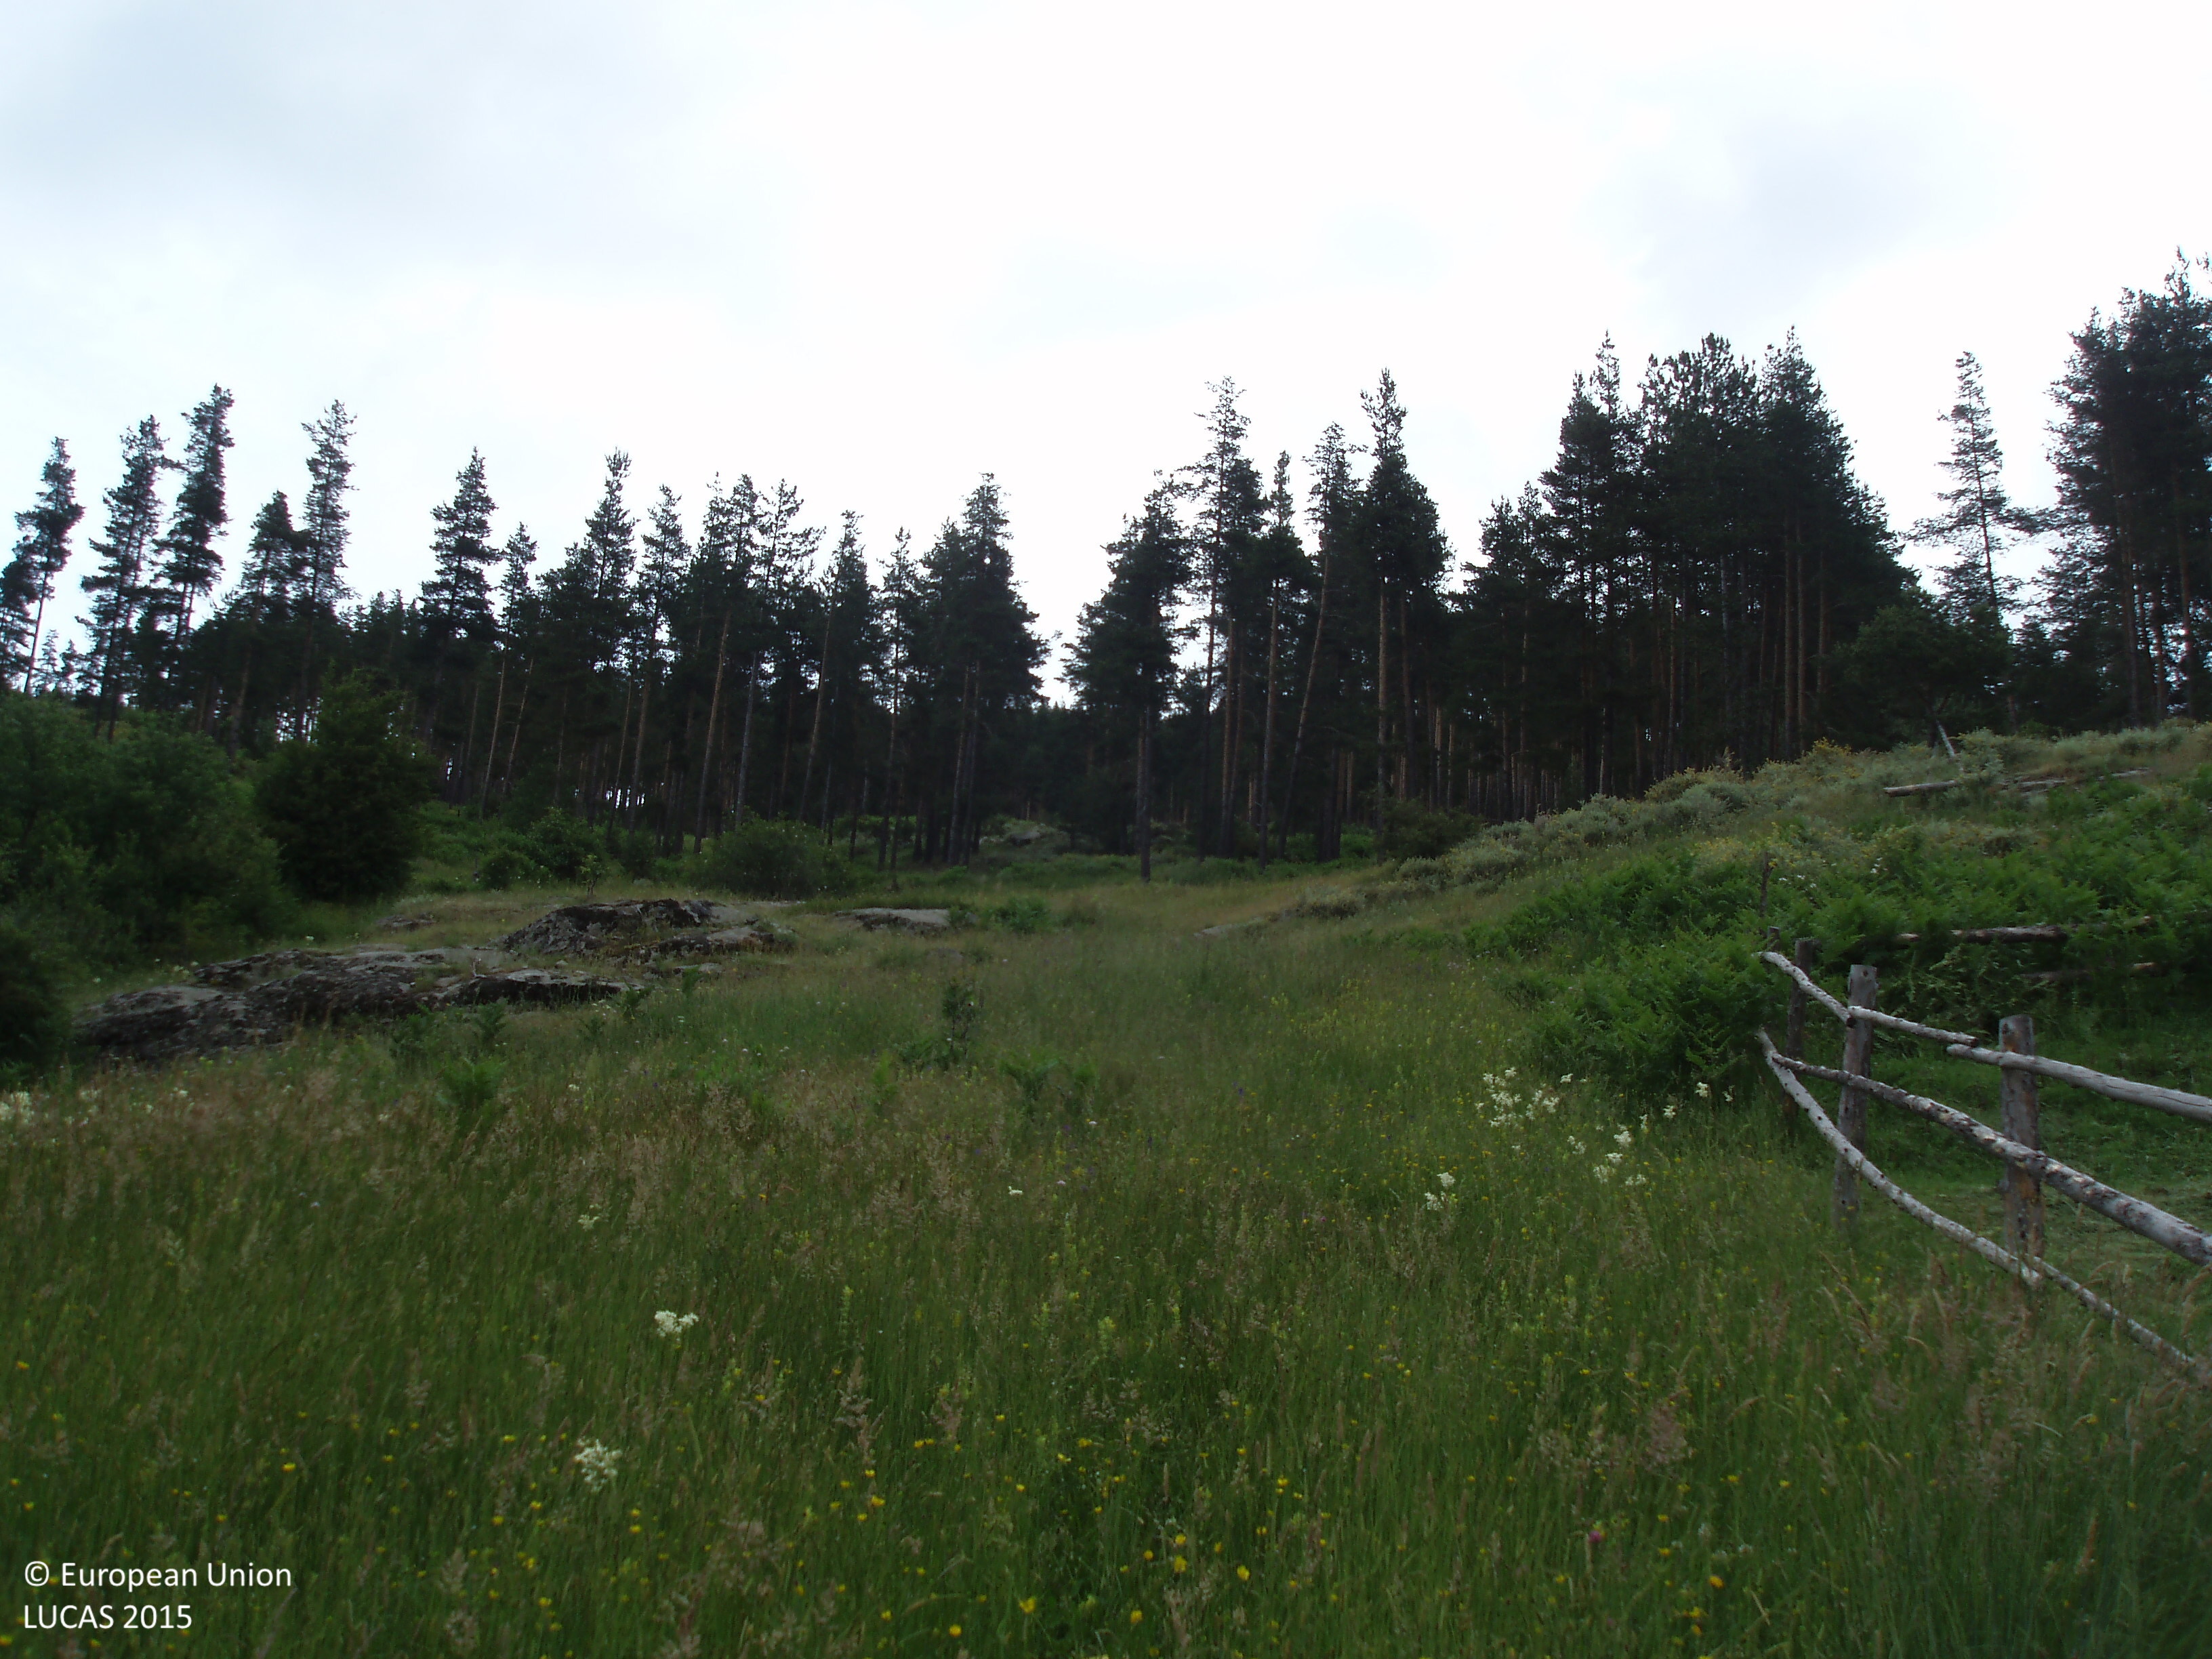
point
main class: Grassland
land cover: Grassland without tree/shrub cover
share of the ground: > 75 %
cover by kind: herbaceous plants 100 %
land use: Agriculture (excluding fallow land and kitchen gardens)
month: June
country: BG
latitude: 41.7266
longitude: 23.7711
